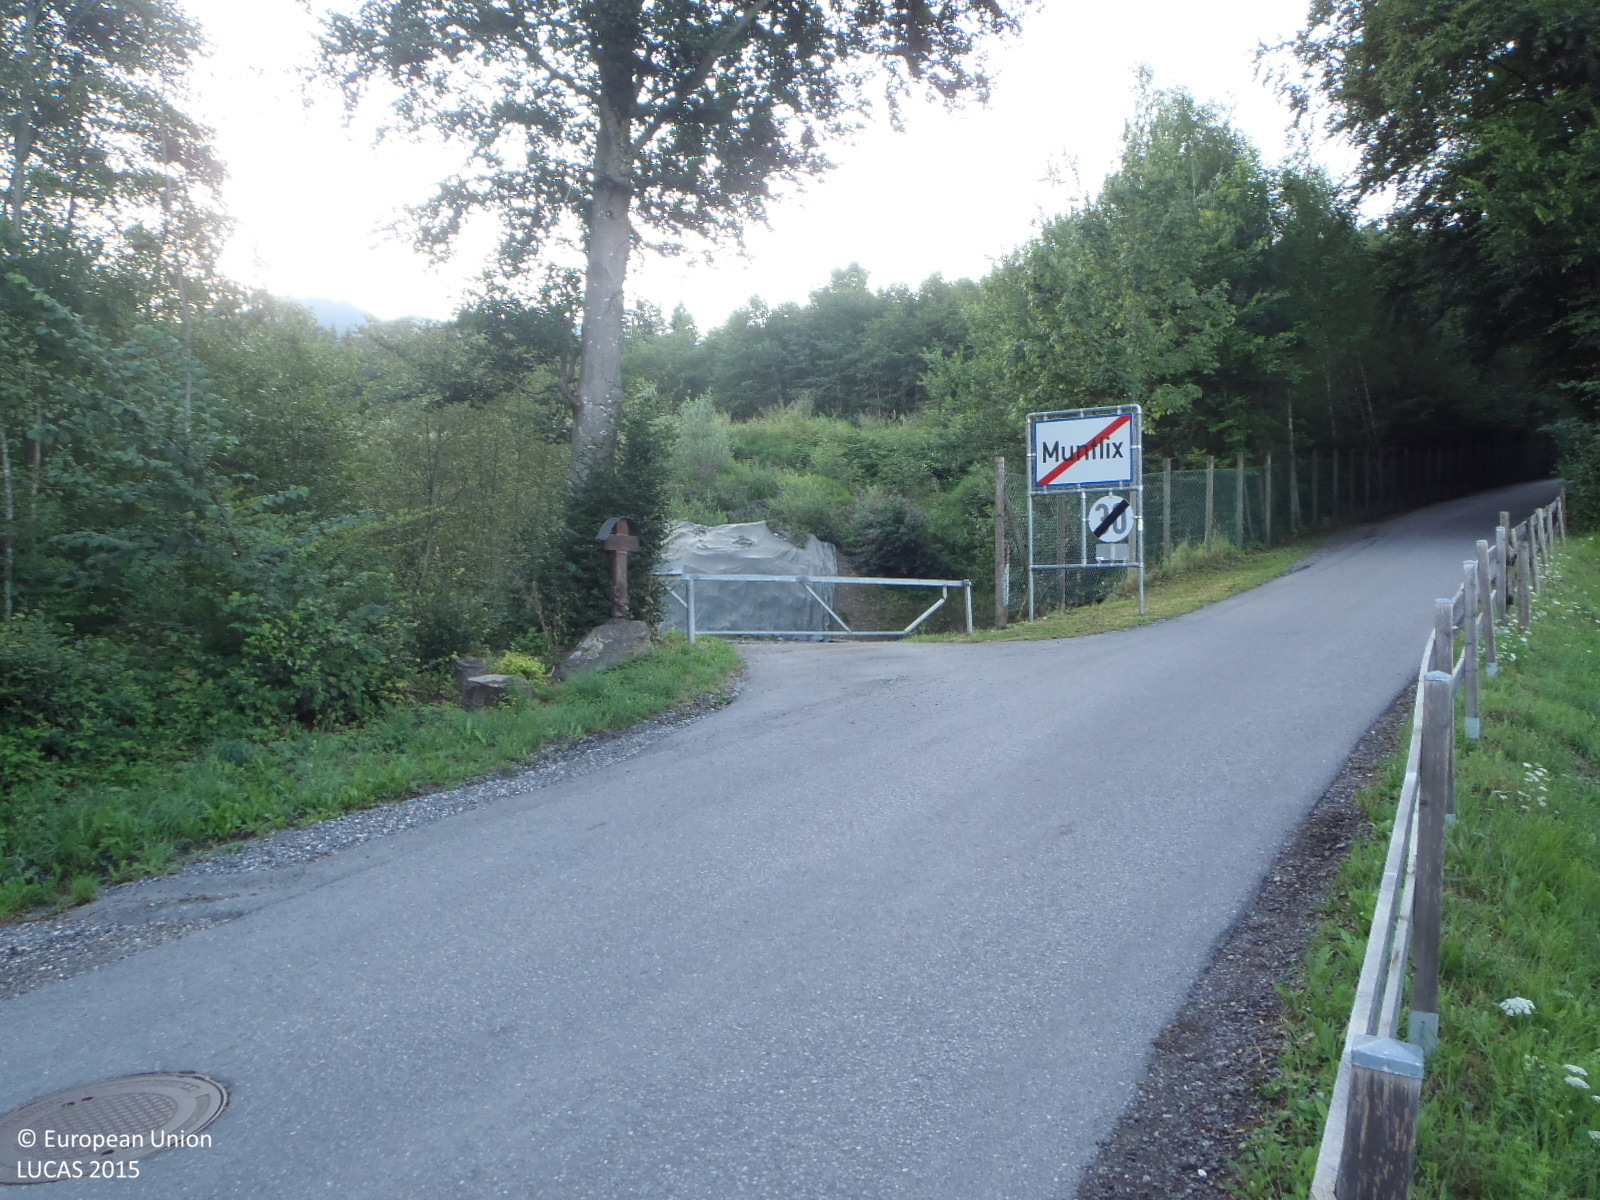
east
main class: Grassland
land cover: Grassland without tree/shrub cover
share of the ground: > 75 %
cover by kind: herbaceous plants 100 %
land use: Agriculture (excluding fallow land and kitchen gardens)
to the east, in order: Grassland without tree/shrub cover; Other mixed woodland; Fences; Broadleaved woodland; Tracks; Other mixed woodland; Rivers and streams; Dry stone walls; Grassland without tree/shrub cover; Other mixed woodland; Tracks; Other mixed woodland; Spruce dominated coniferous woodland
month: July
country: AT
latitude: 47.2871
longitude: 9.6698
